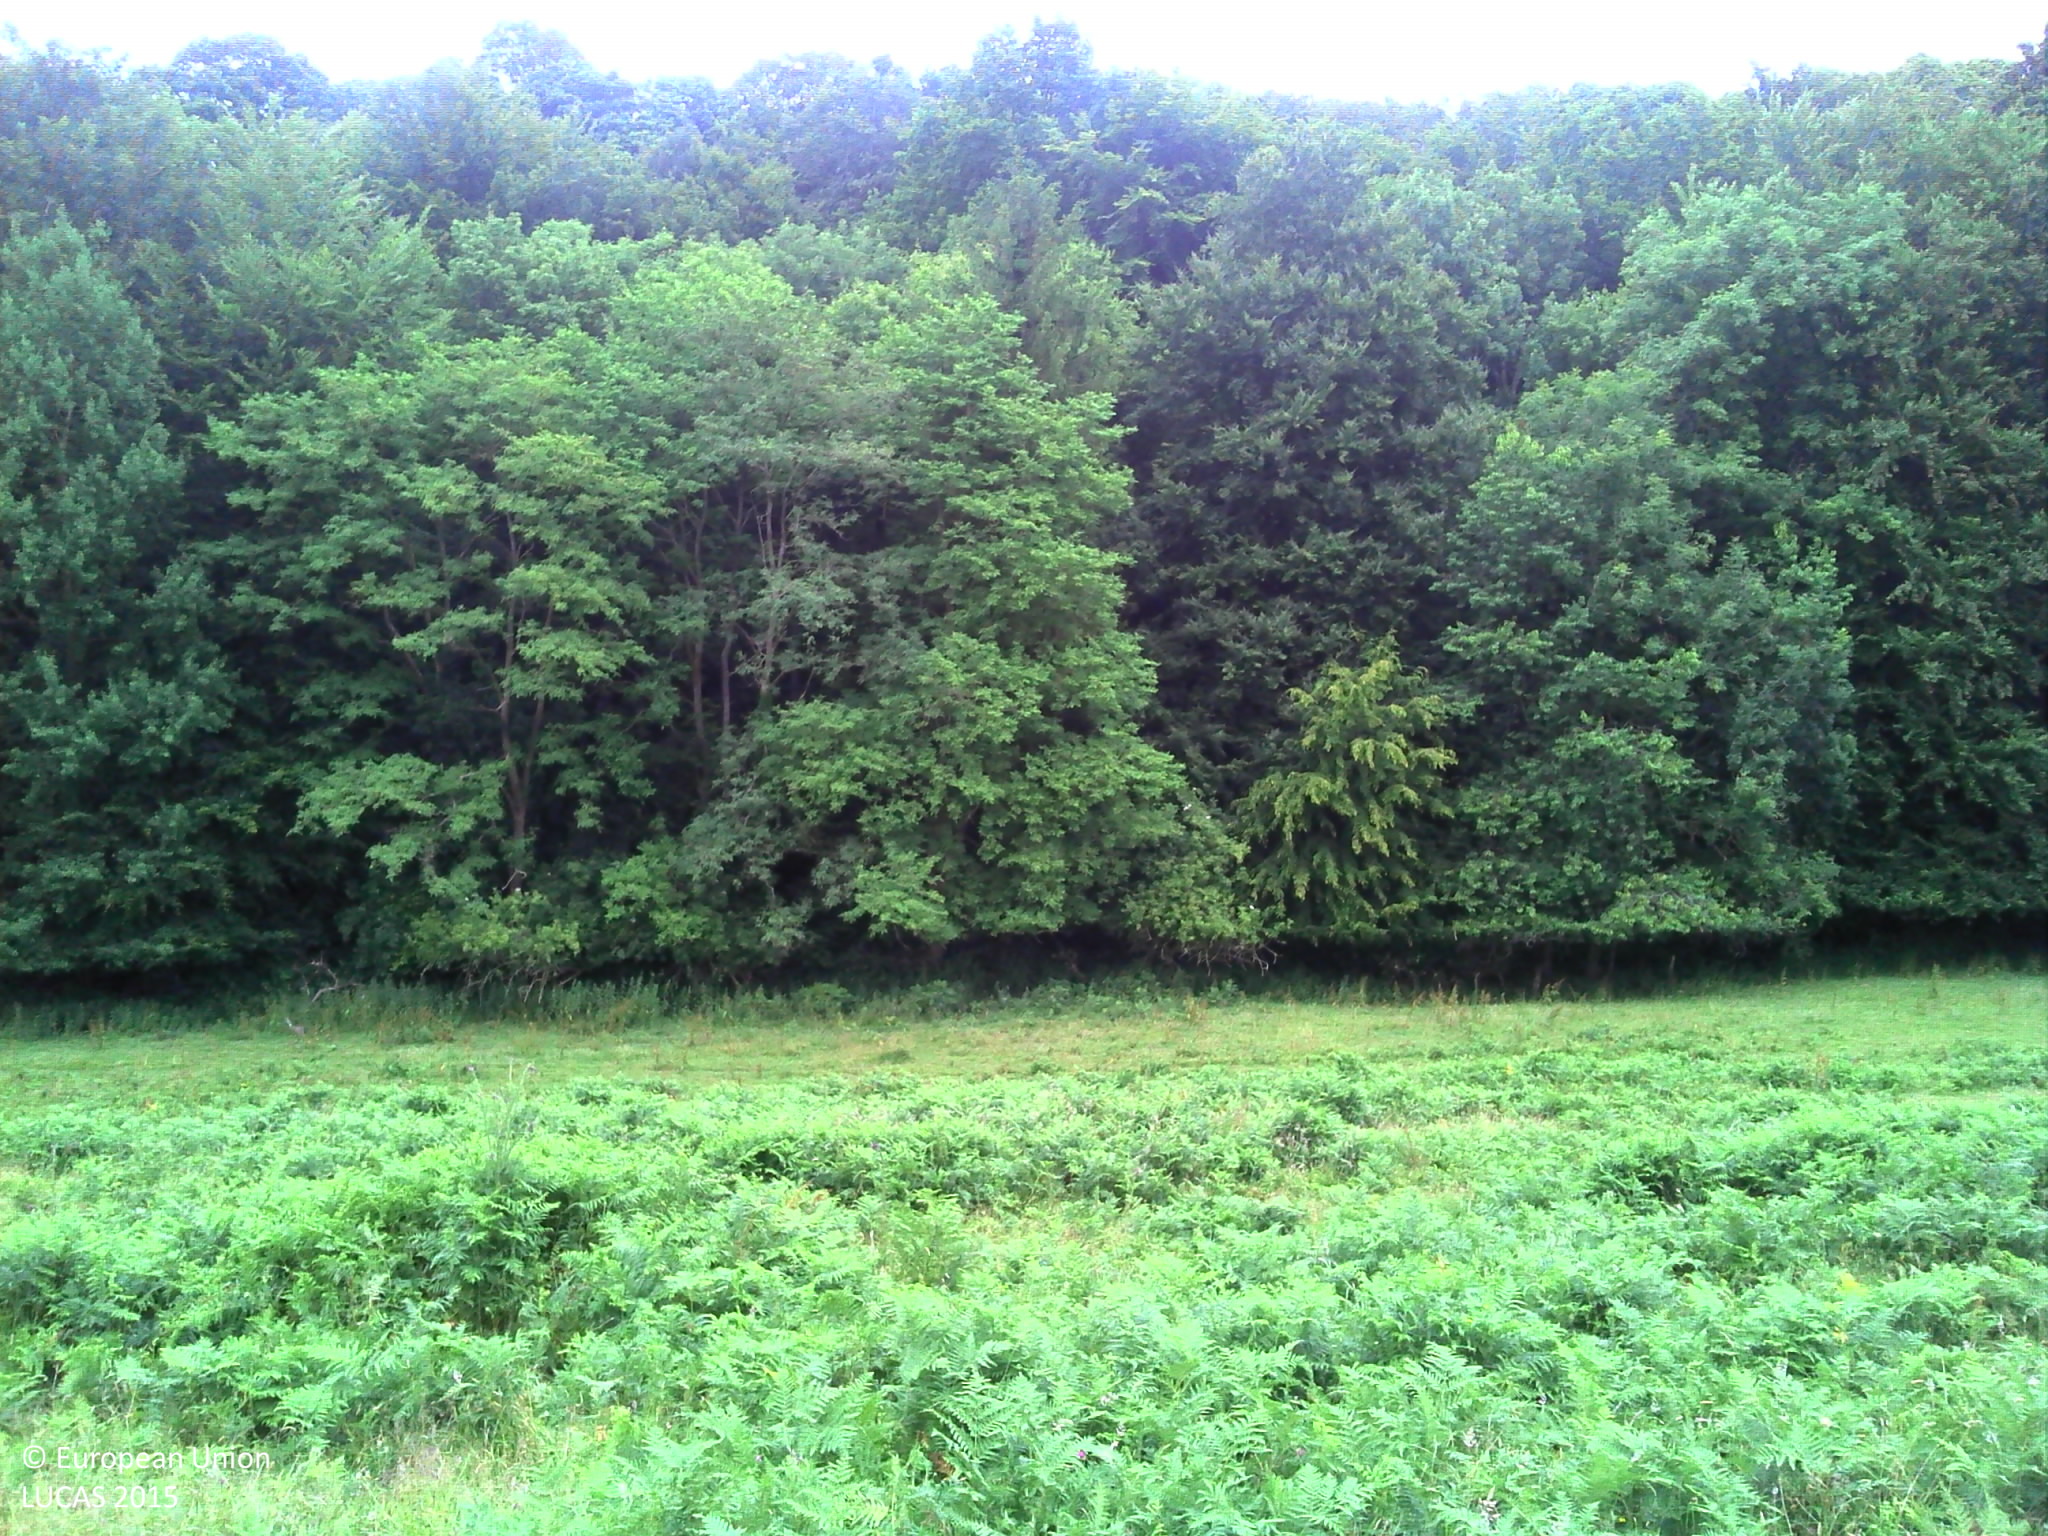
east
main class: Grassland
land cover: Spontaneously vegetated surfaces
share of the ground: > 75 %
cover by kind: herbaceous plants 100 %
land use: Agriculture (excluding fallow land and kitchen gardens)
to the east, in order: Spontaneously vegetated surfaces; Fences; Broadleaved woodland
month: July
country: FR
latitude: 49.3371
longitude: 0.3246
